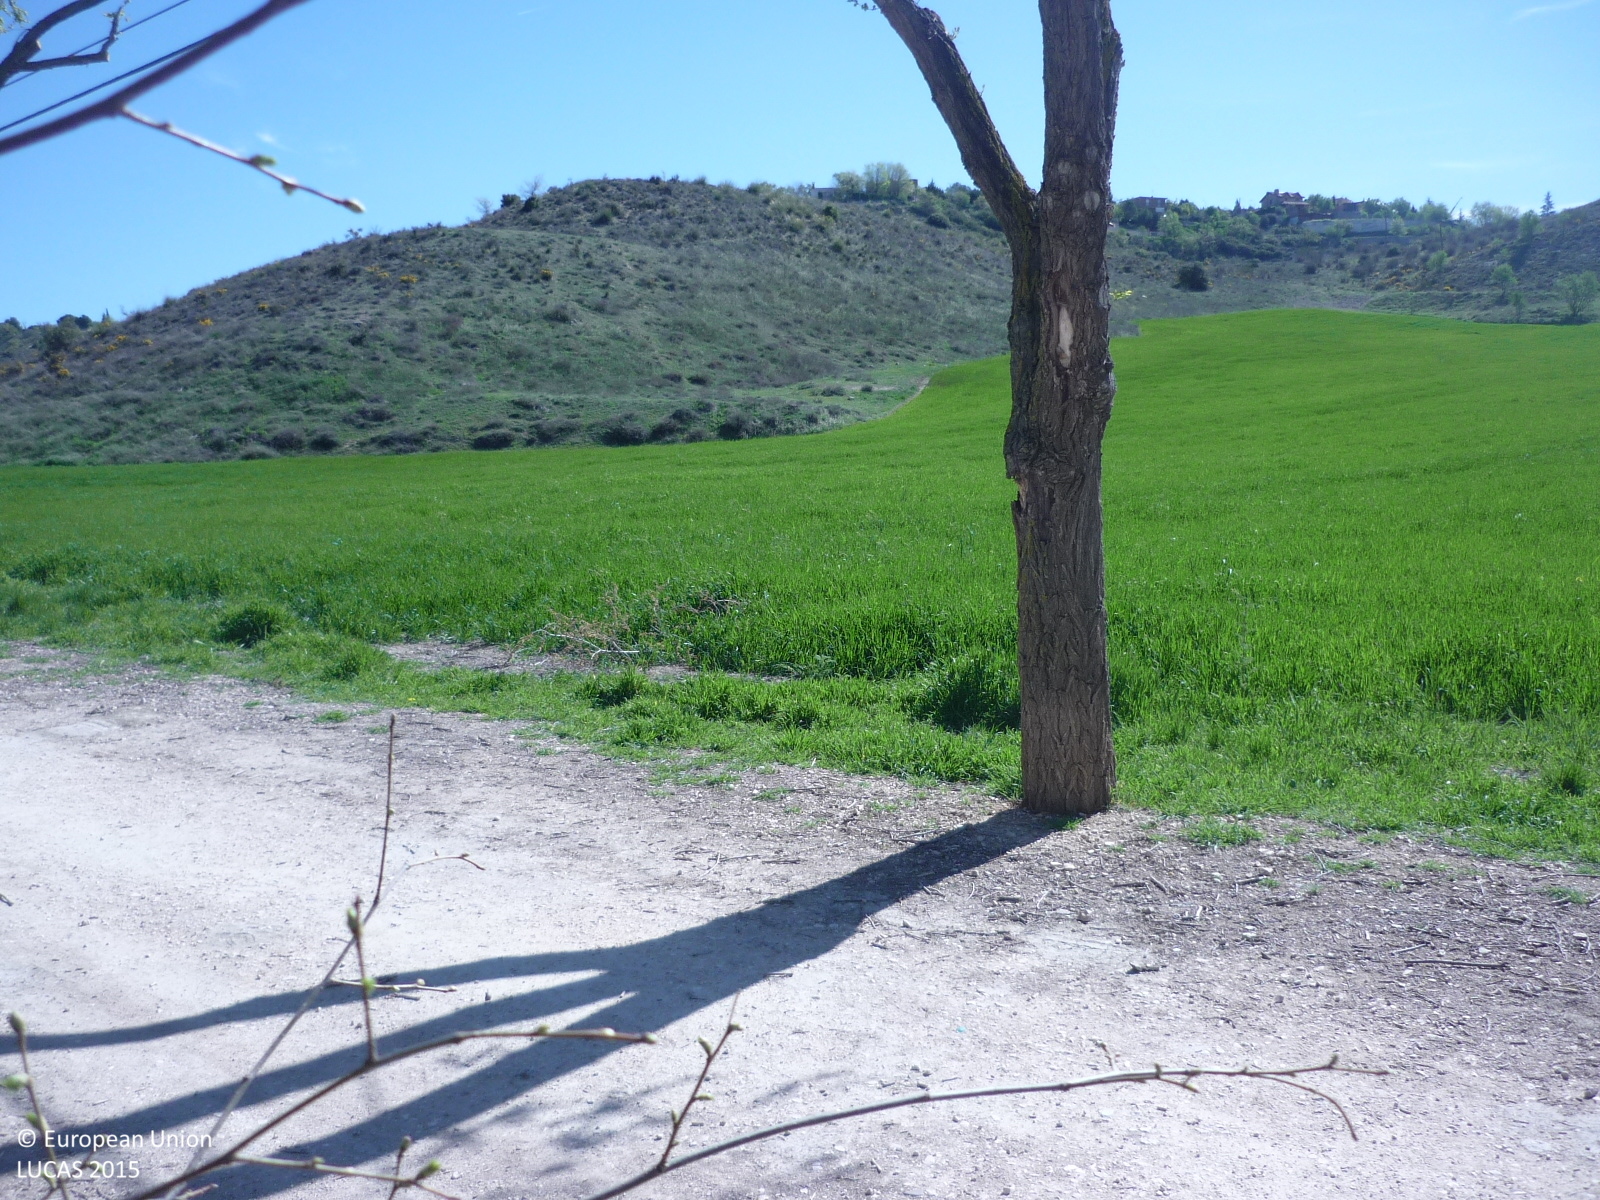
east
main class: Woodland
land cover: Broadleaved woodland
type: thermophilous deciduous forest
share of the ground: 50 - 75 %
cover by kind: broadleaved forest trees 70 %, unconsolidated bare surface 30 %
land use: Amenities, museums, leisure
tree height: < 5 m
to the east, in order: Broadleaved woodland; Tracks; Barley; Tracks; Shrubland without tree cover; Grassland with sparse tree/shrub cover; Other bare soil
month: April
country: ES
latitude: 40.4381
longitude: -3.2951
